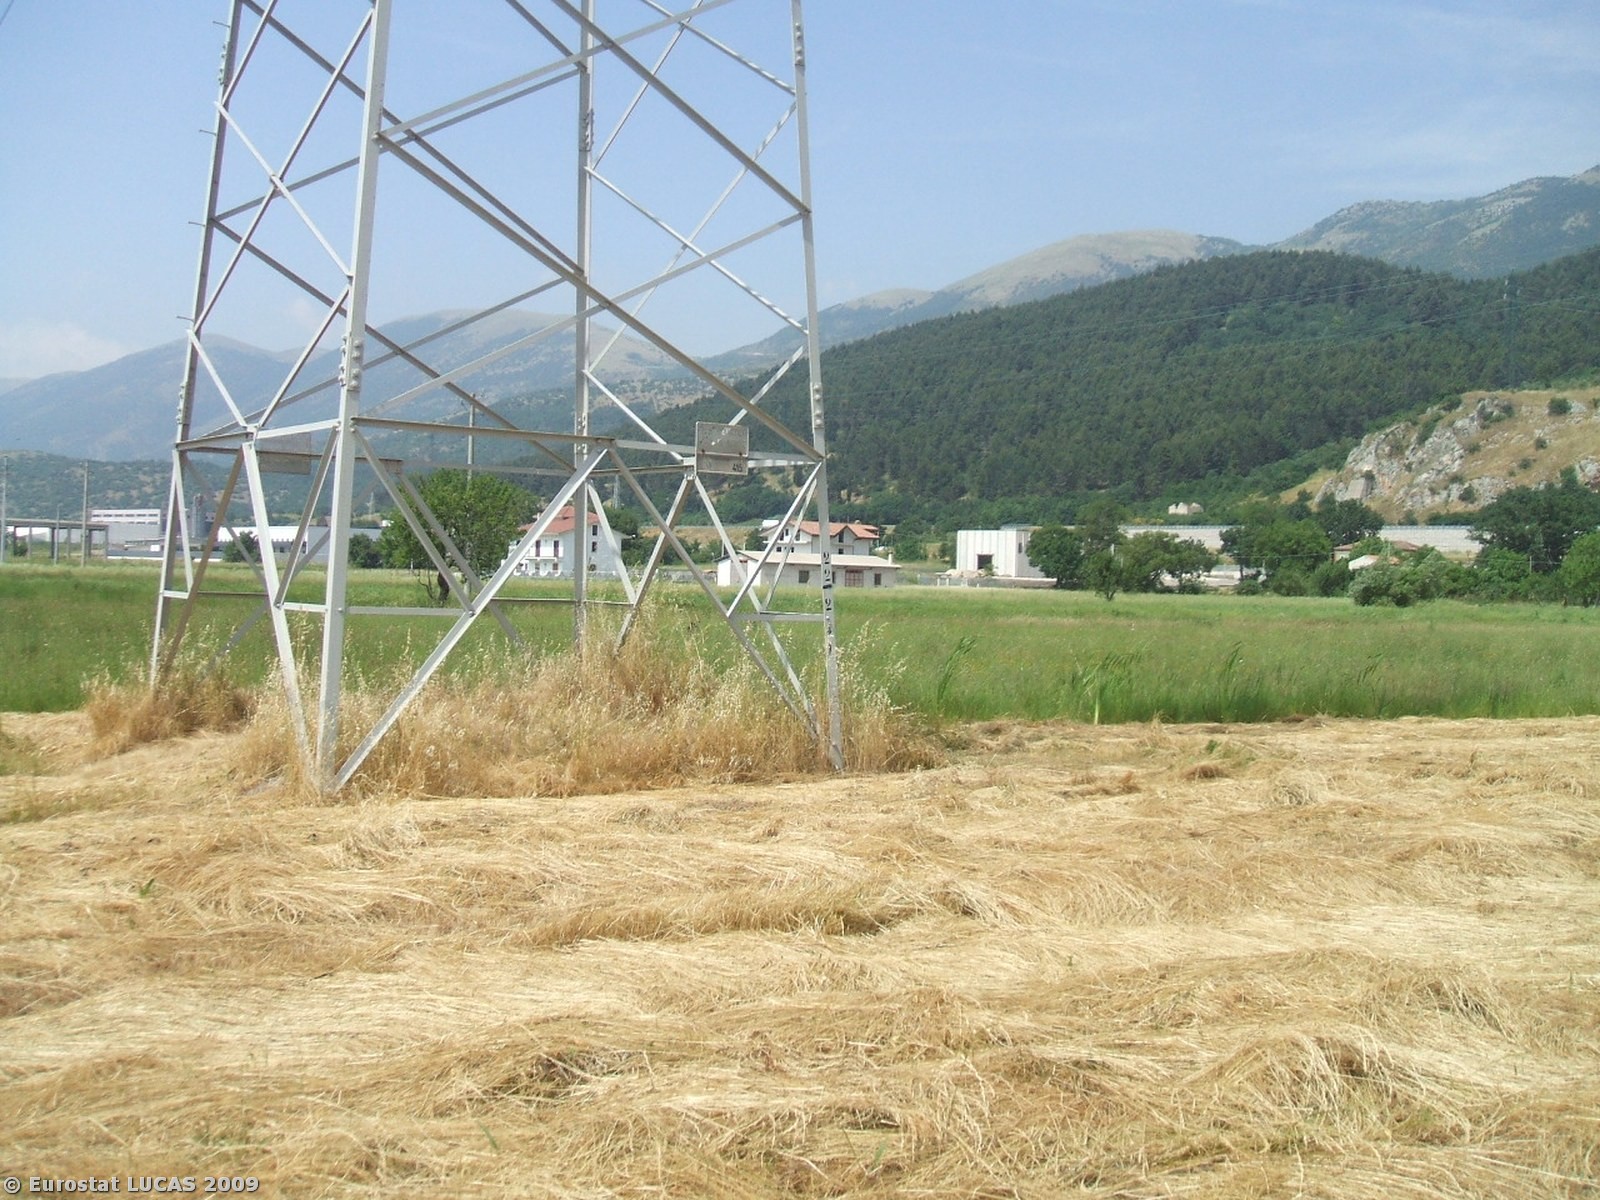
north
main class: Cropland
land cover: Other leguminous and mixtures for fodder
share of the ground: > 75 %
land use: Agriculture (excluding fallow land and kitchen gardens)
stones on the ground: < 10 %
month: May
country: IT
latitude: 40.4739
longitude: 15.5329
